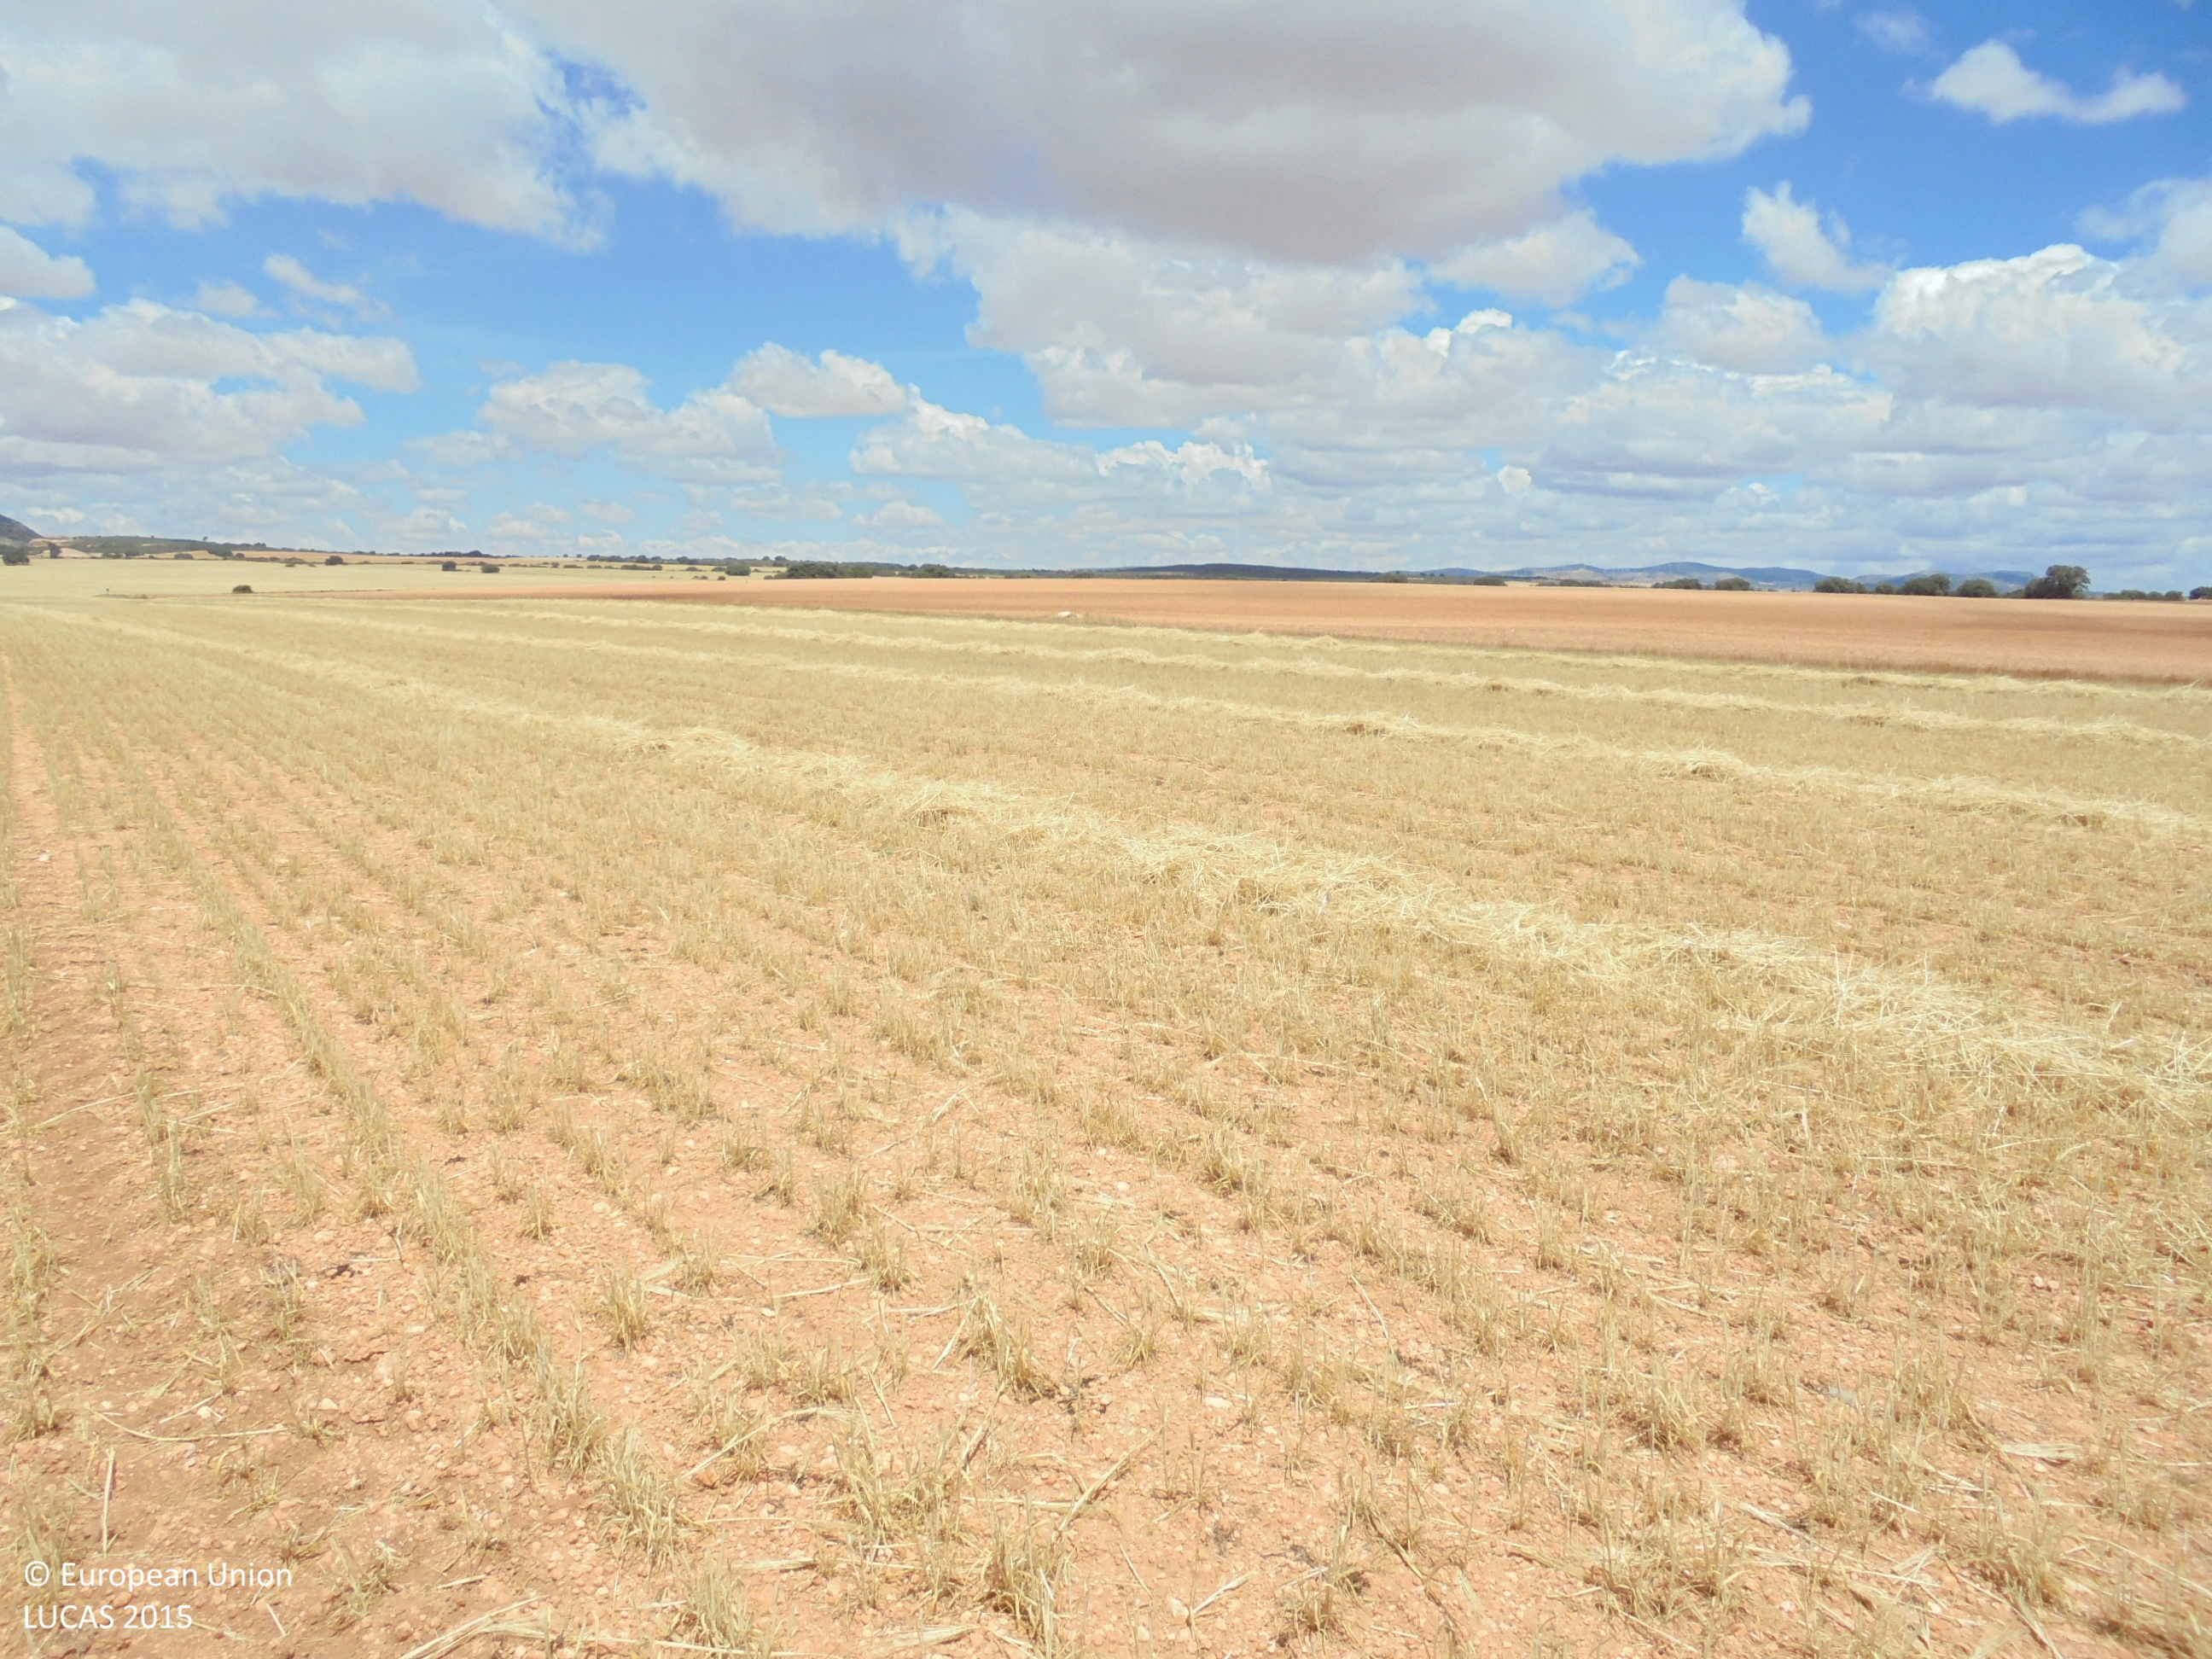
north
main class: Cropland
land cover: Barley
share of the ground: 50 - 75 %
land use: Agriculture (excluding fallow land and kitchen gardens)
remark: Harvested field
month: June
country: ES
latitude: 38.8652
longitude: -1.4403
